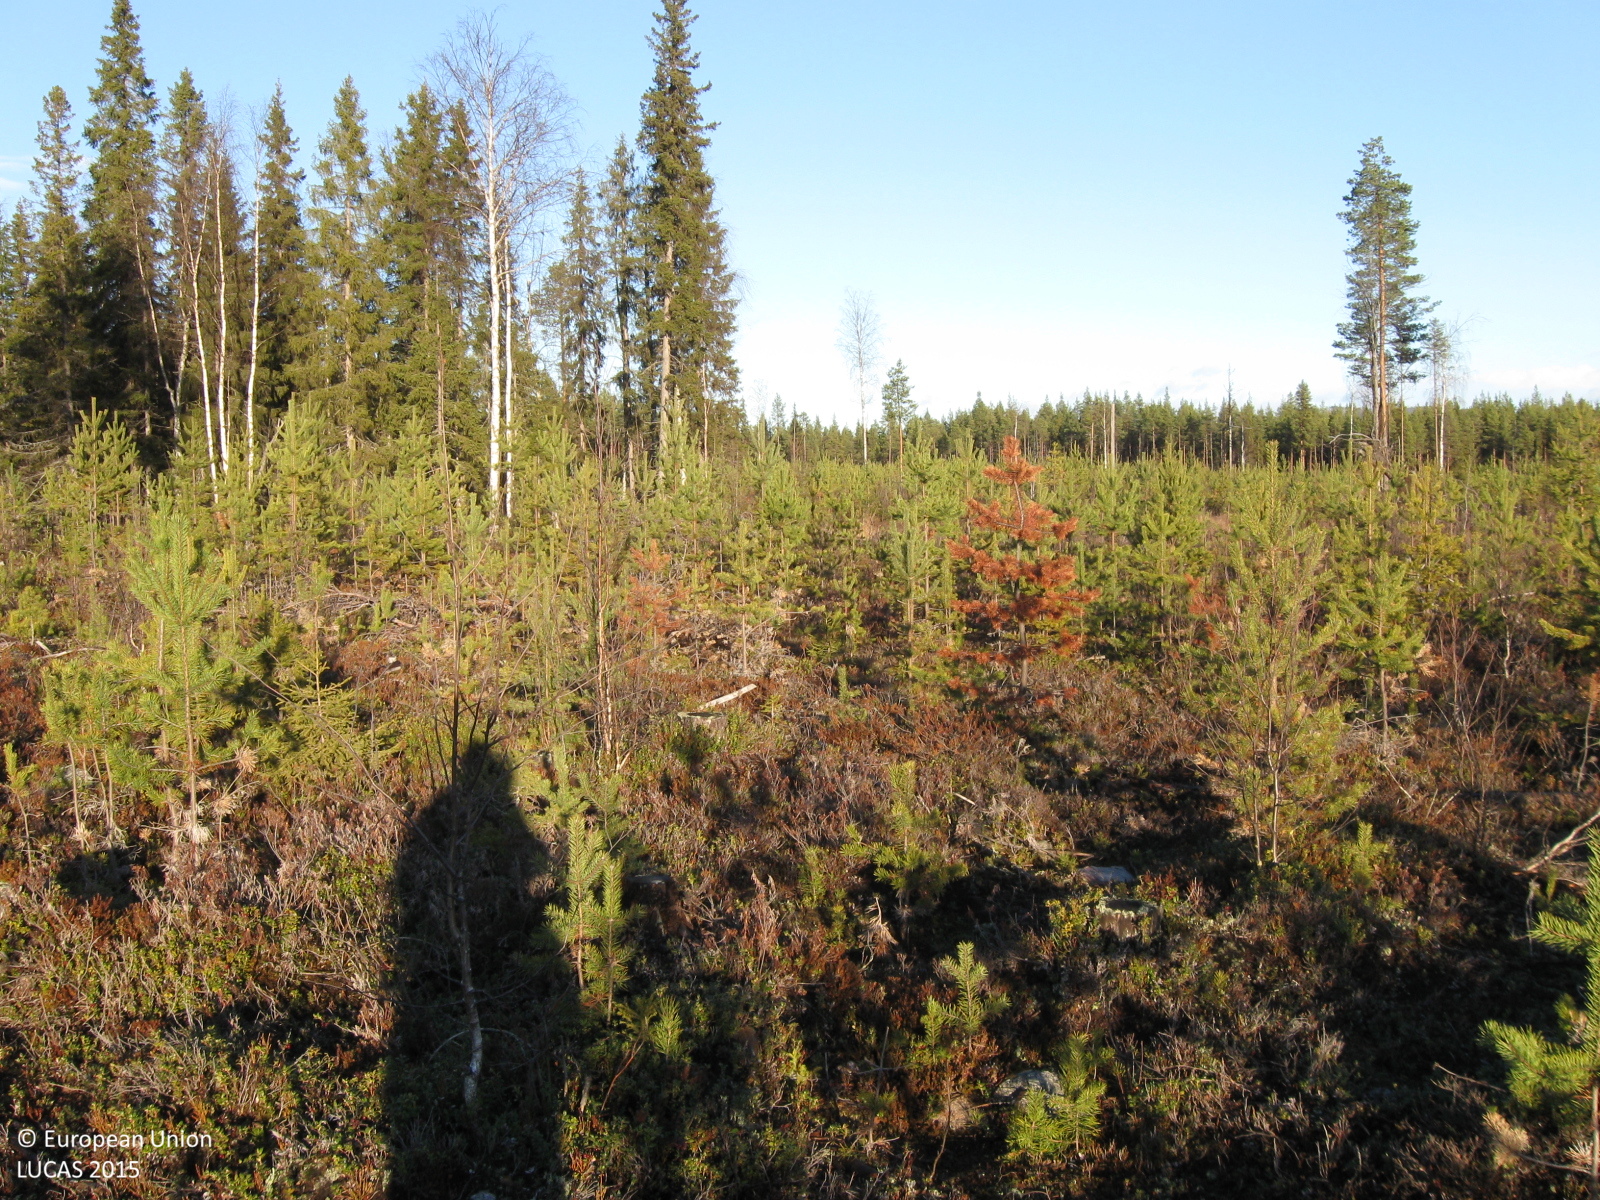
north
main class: Woodland
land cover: Pine dominated coniferous woodland
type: boreal forest
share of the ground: 25 - 50 %
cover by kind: coniferous forest trees 30 %, shrubs 20 %, herbaceous plants 10 %, lichens and mosses 10 %, consolidated bare surface 10 %, unconsolidated bare surface 10 %, broadleaved forest trees 5 %
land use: Forestry
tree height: < 5 m
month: November
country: SE
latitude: 66.1134
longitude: 20.7845
